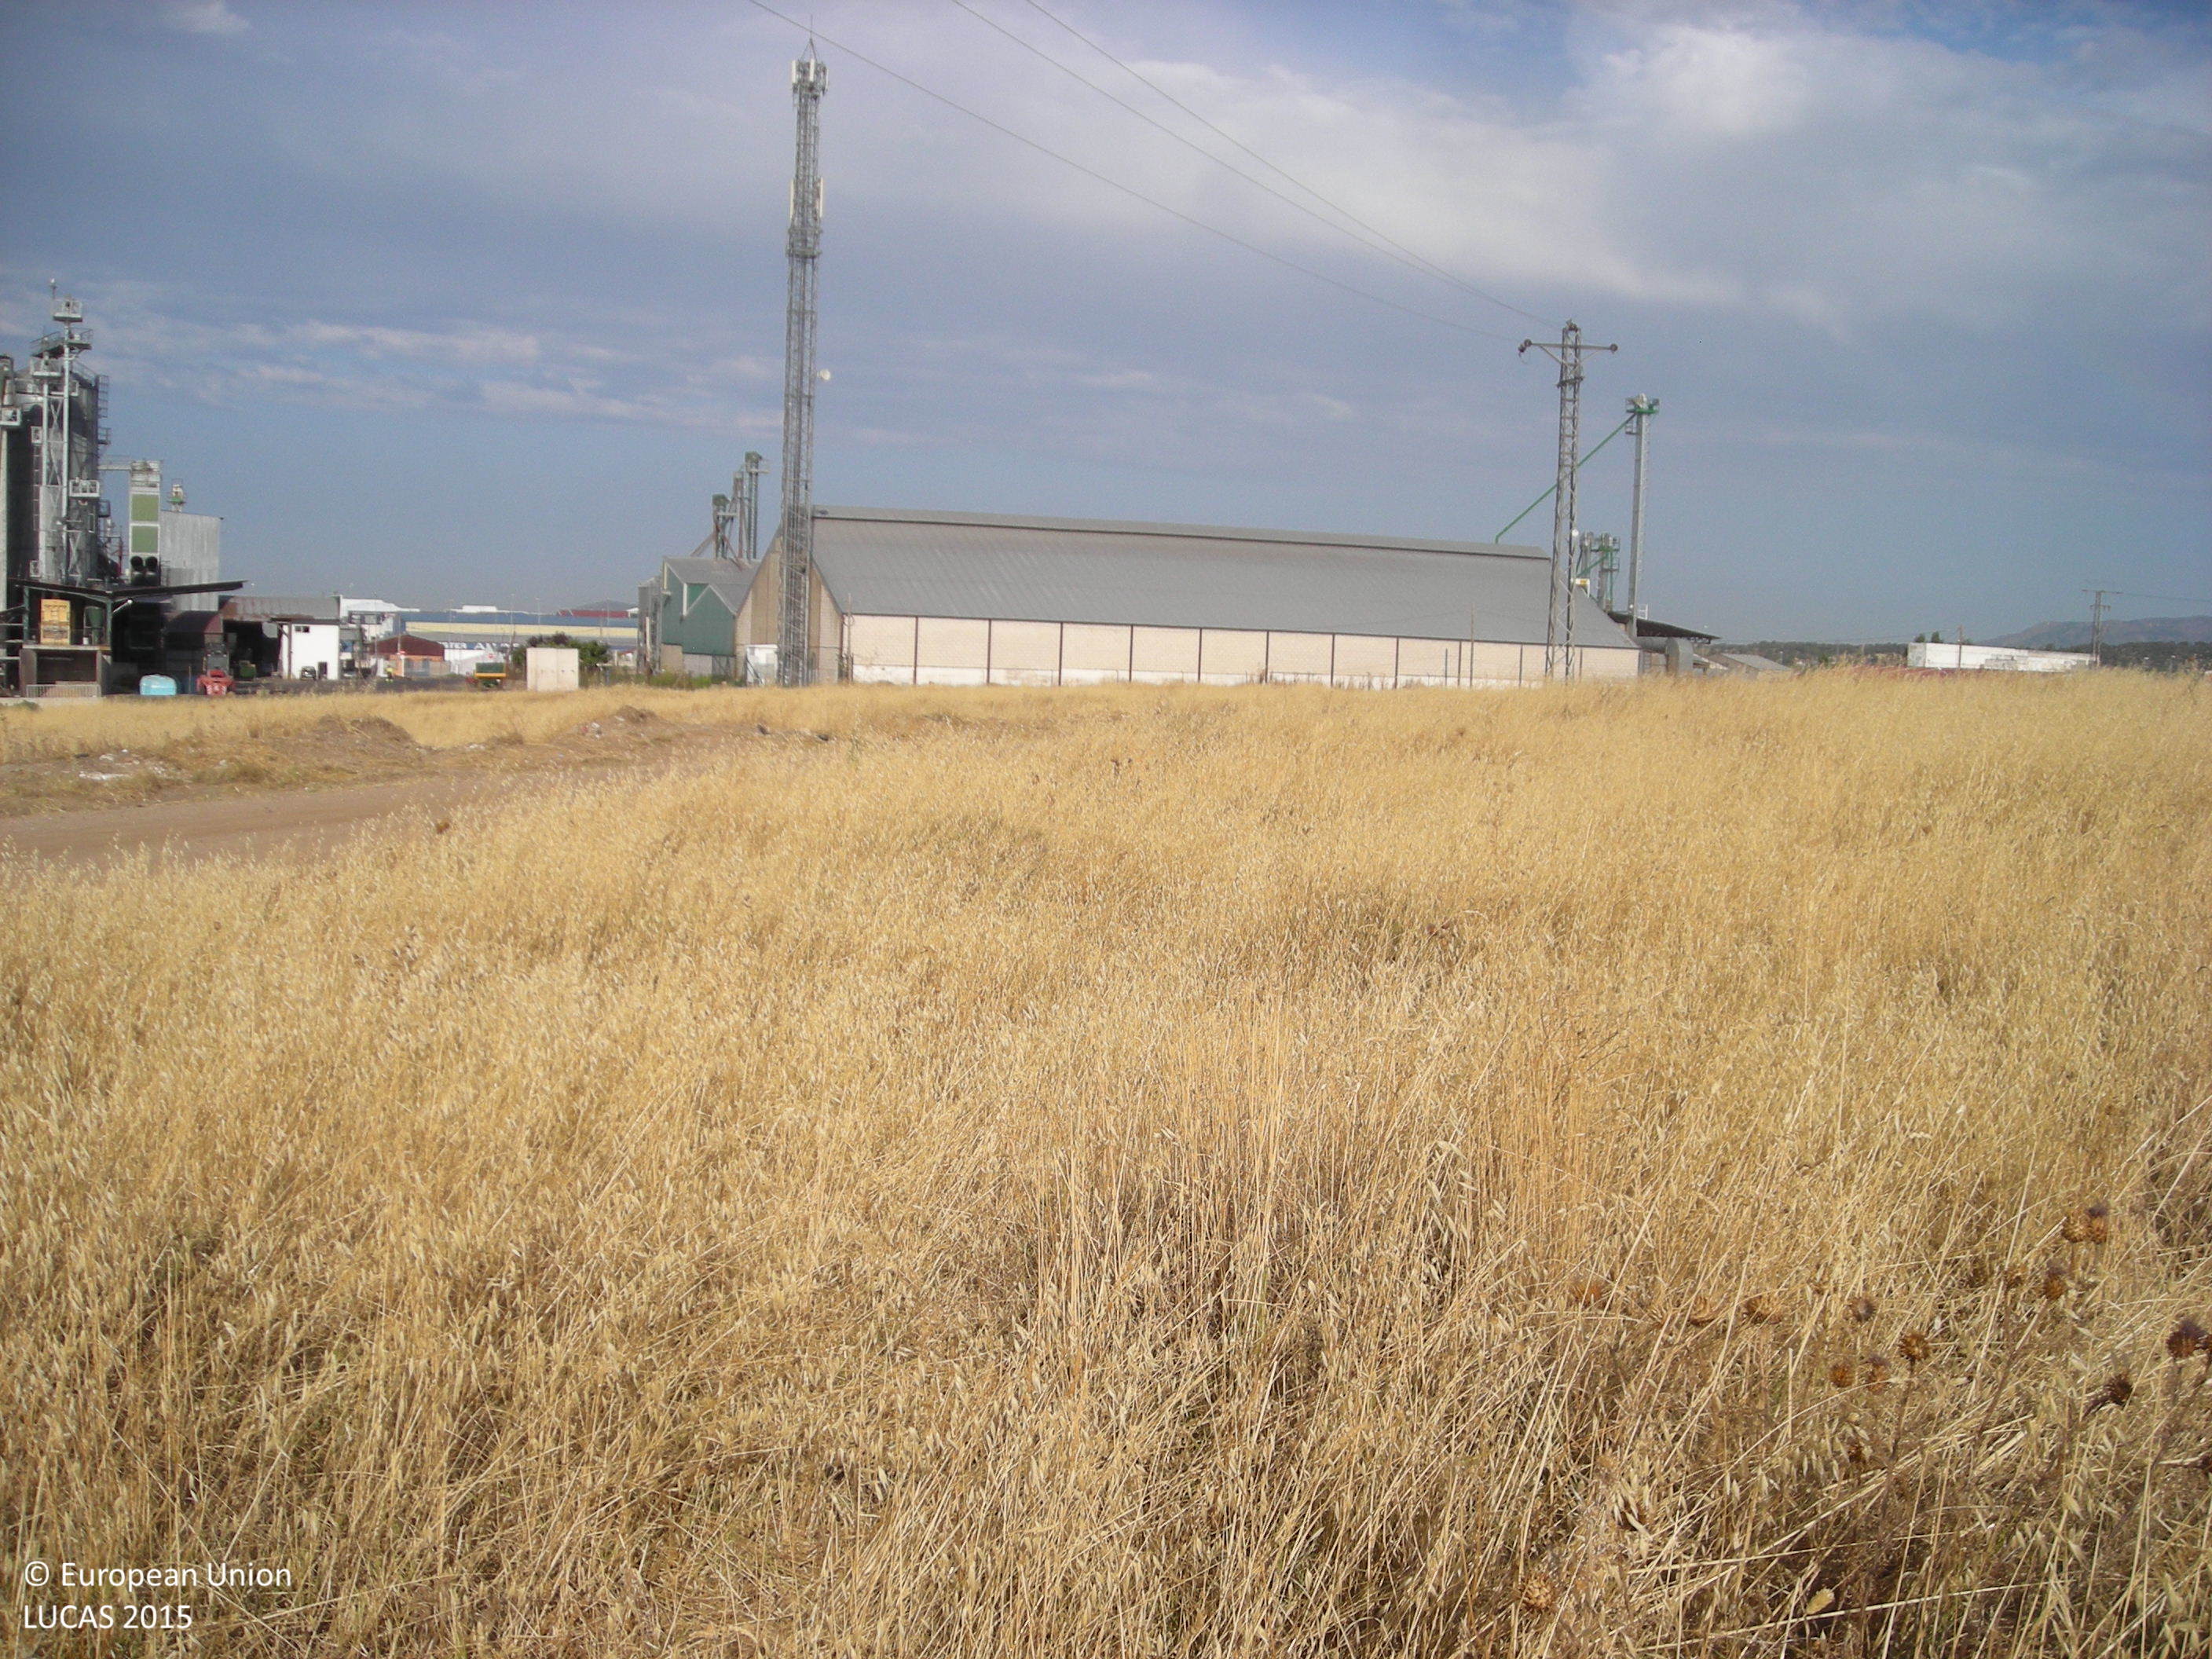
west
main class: Grassland
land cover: Spontaneously vegetated surfaces
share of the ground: 50 - 75 %
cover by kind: herbaceous plants 100 %
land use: Abandoned areas
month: July
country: ES
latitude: 39.1427
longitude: -5.9159
